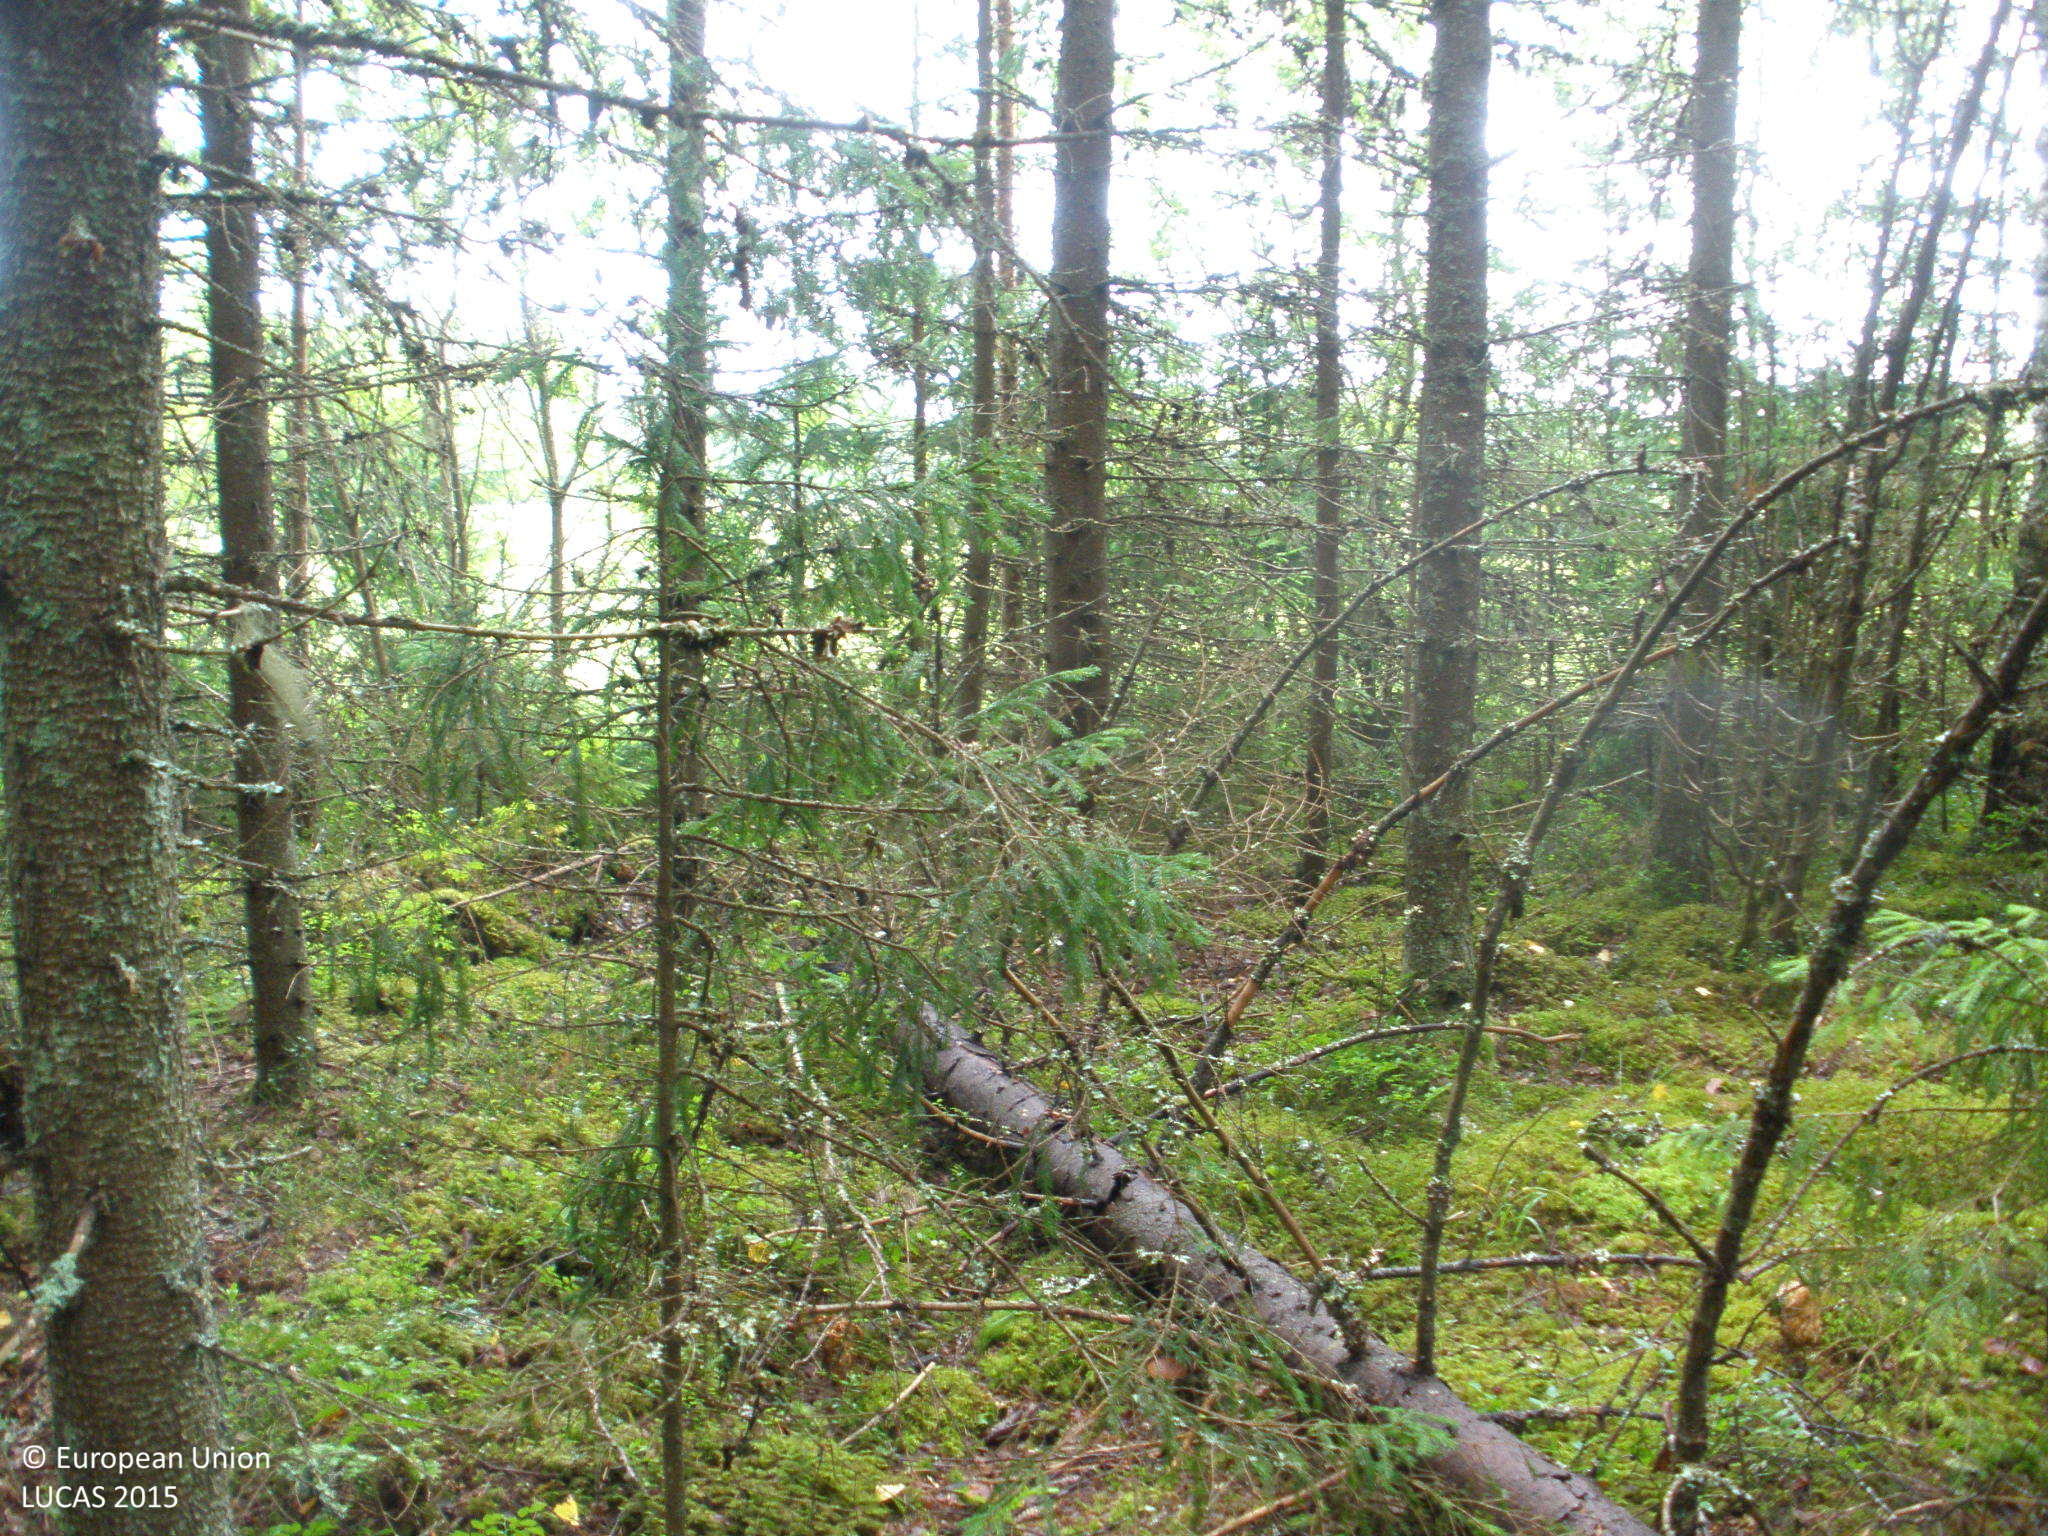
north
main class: Woodland
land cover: Spruce dominated coniferous woodland
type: boreal forest
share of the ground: > 75 %
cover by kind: coniferous forest trees 95 %, lichens and mosses 5 %
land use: Forestry
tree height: > 5 m
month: July
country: FI
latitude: 60.6732
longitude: 23.3899
